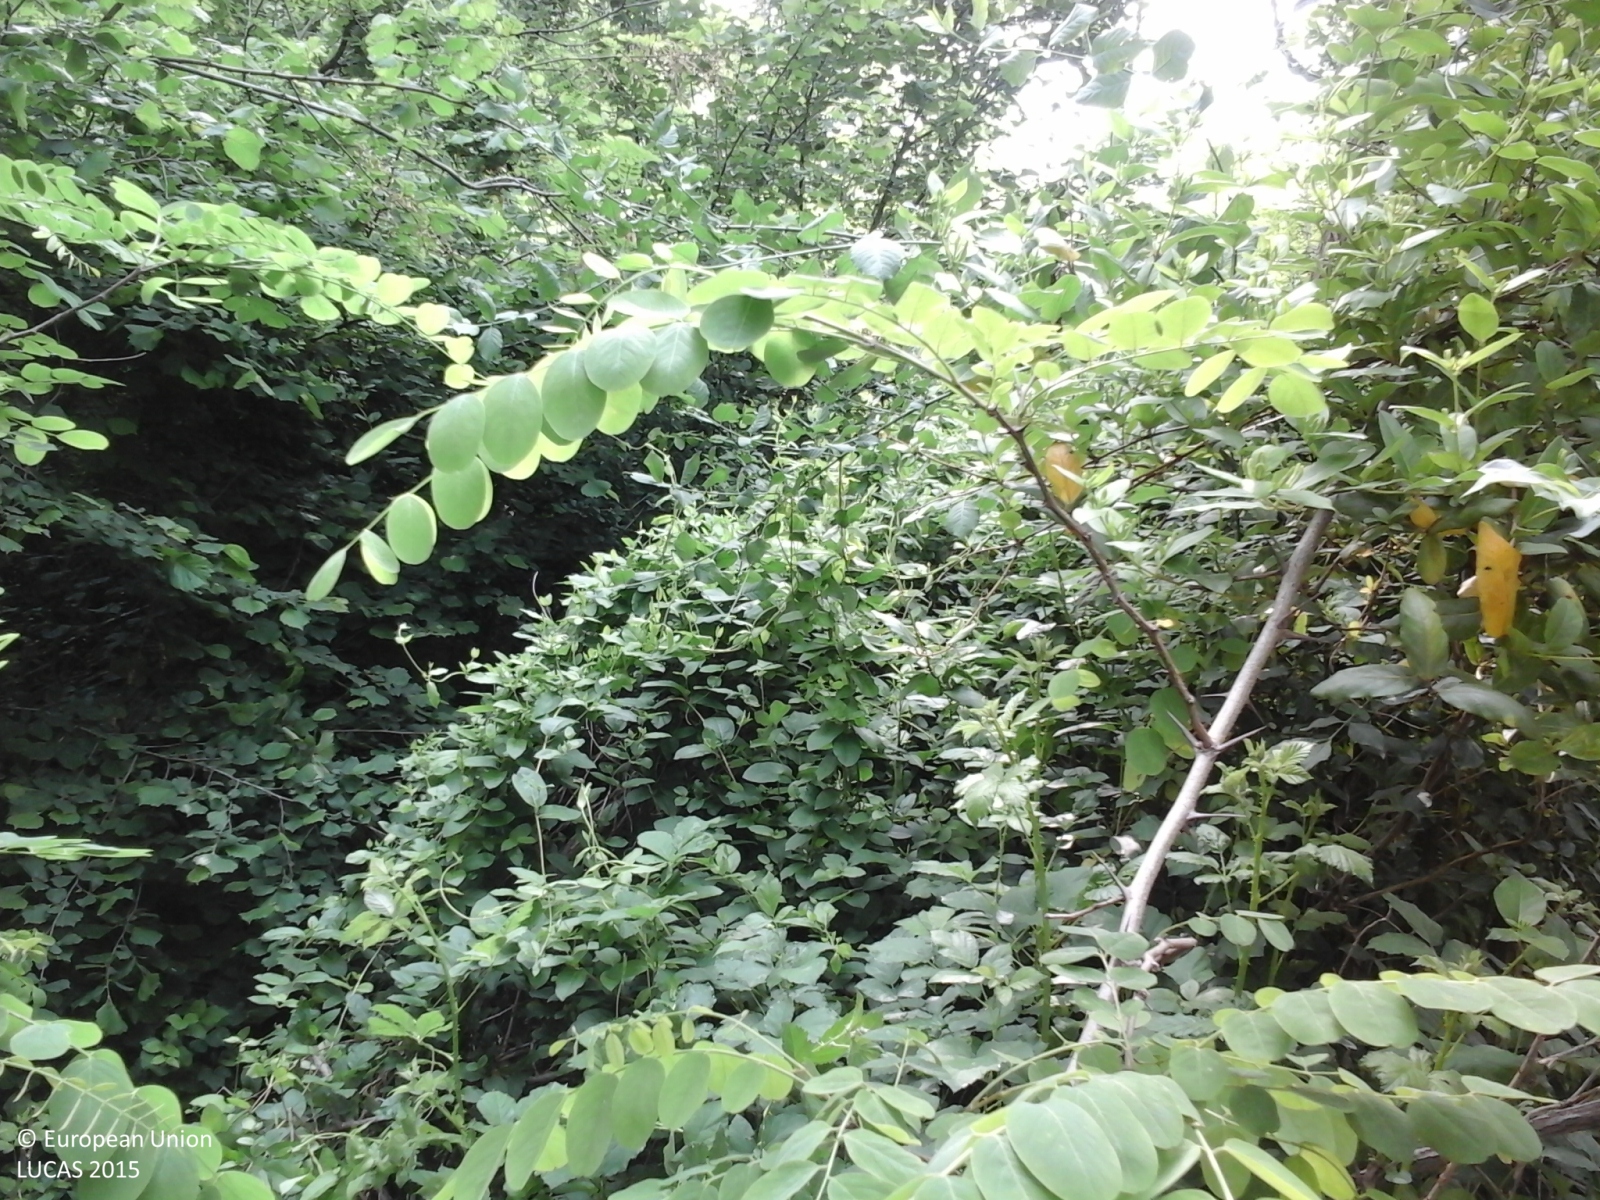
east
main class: Woodland
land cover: Broadleaved woodland
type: thermophilous deciduous forest
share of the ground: > 75 %
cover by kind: broadleaved forest trees 100 %
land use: Forestry
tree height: > 5 m
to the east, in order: Broadleaved woodland; Ditches and canals; Broadleaved woodland
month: May
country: IT
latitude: 45.5284
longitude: 8.4021
